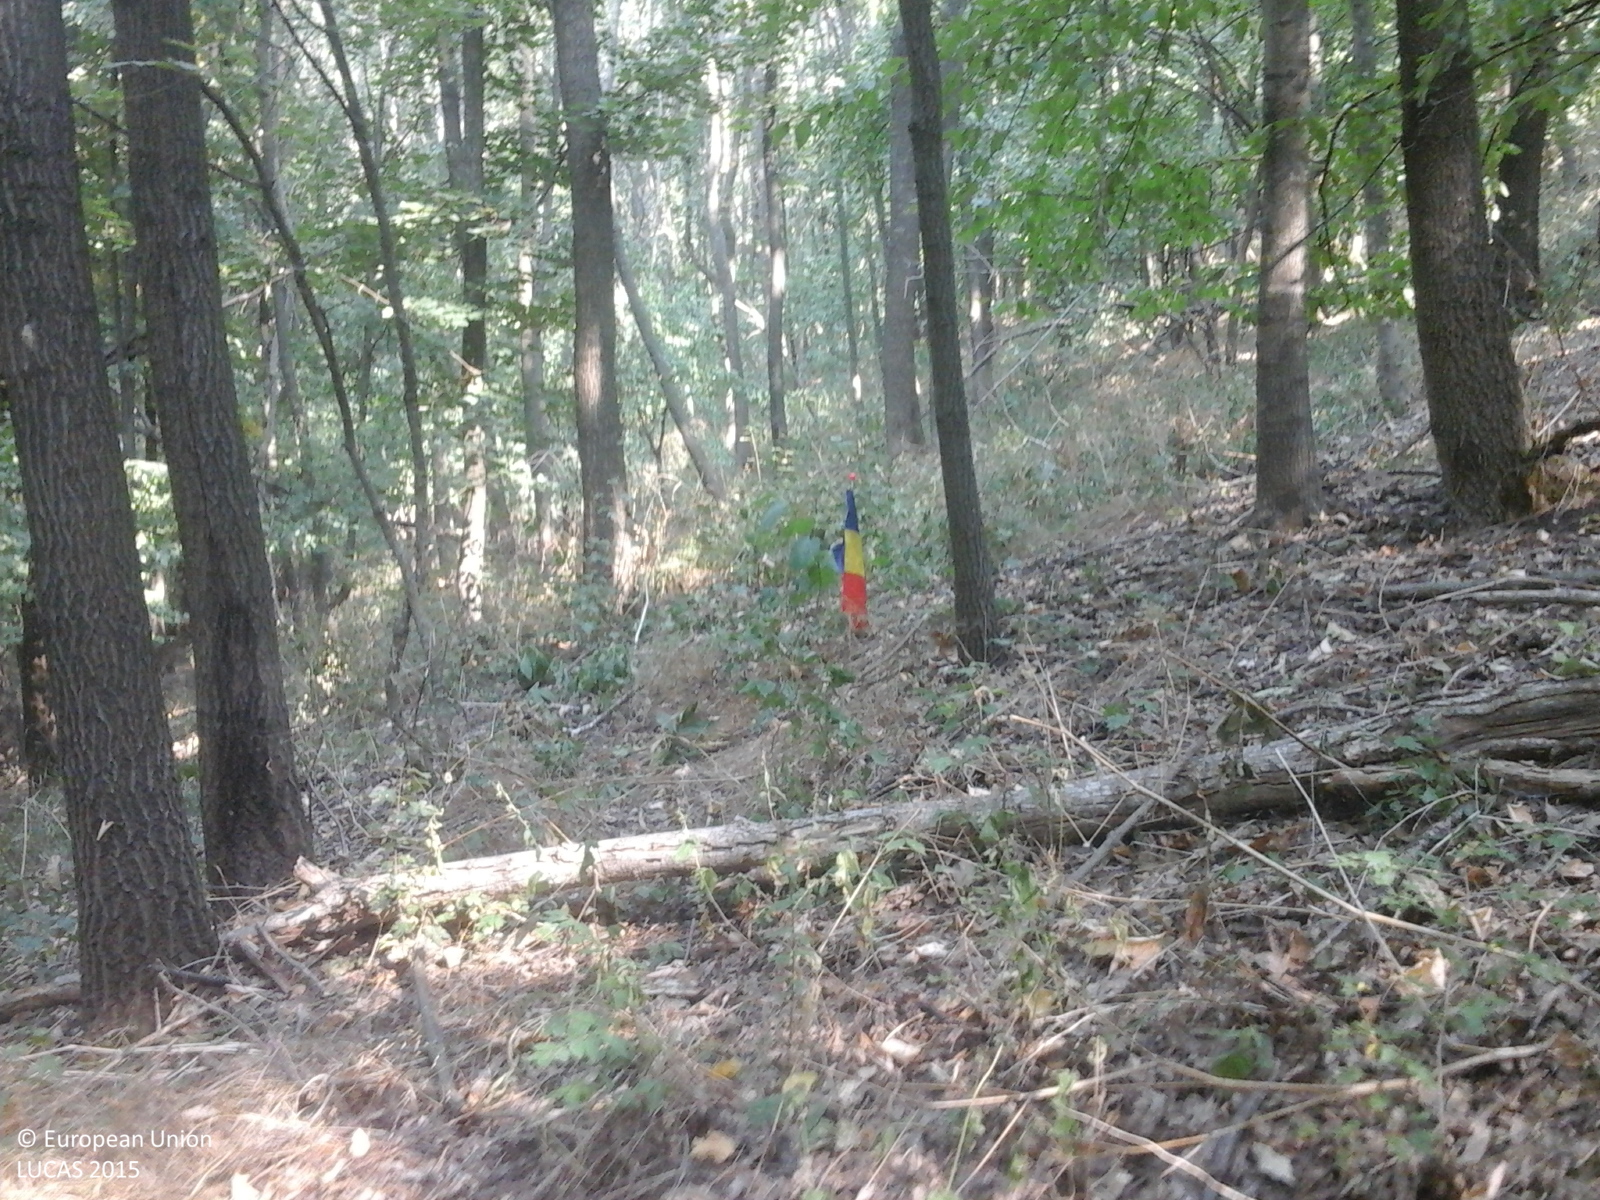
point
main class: Woodland
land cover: Broadleaved woodland
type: acidophilous oak and oak-birch forest
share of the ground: > 75 %
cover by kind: broadleaved forest trees 100 %
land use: Forestry
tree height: > 5 m
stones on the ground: < 10 %
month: August
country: RO
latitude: 44.2533
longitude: 23.7443
